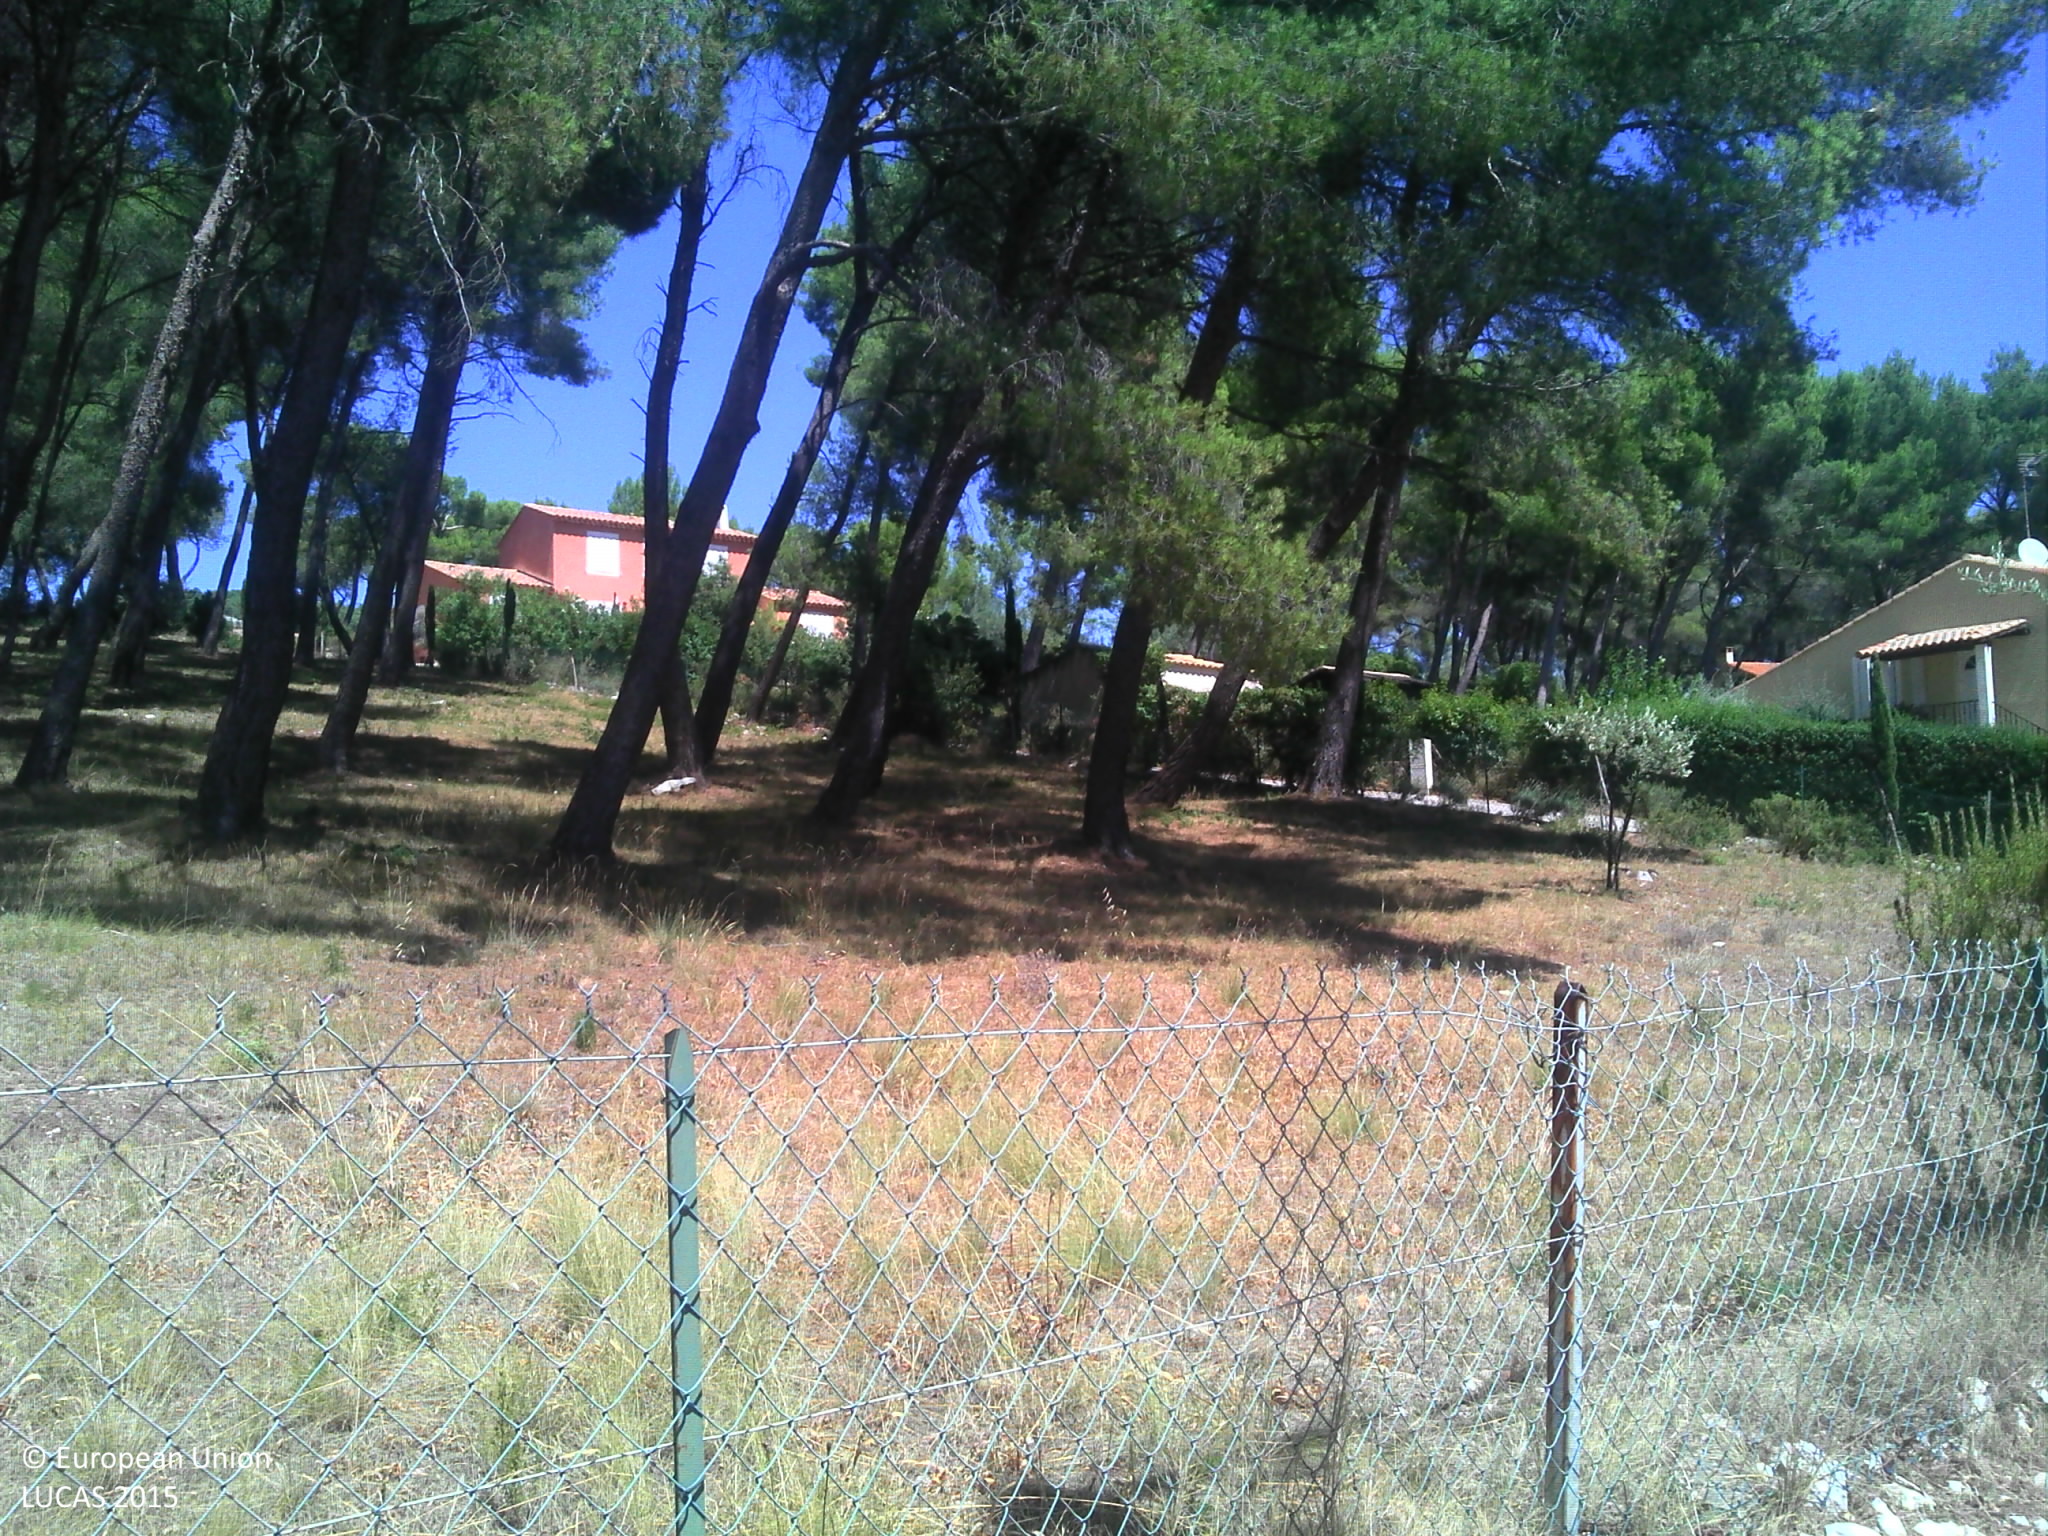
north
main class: Woodland
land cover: Pine dominated coniferous woodland
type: coniferous forest of the mediterranean region
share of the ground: > 75 %
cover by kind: coniferous forest trees 80 %, herbaceous plants 15 %, consolidated bare surface 5 %
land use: Forestry
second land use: Residential
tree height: > 5 m
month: August
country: FR
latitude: 43.2259
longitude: 5.5658
